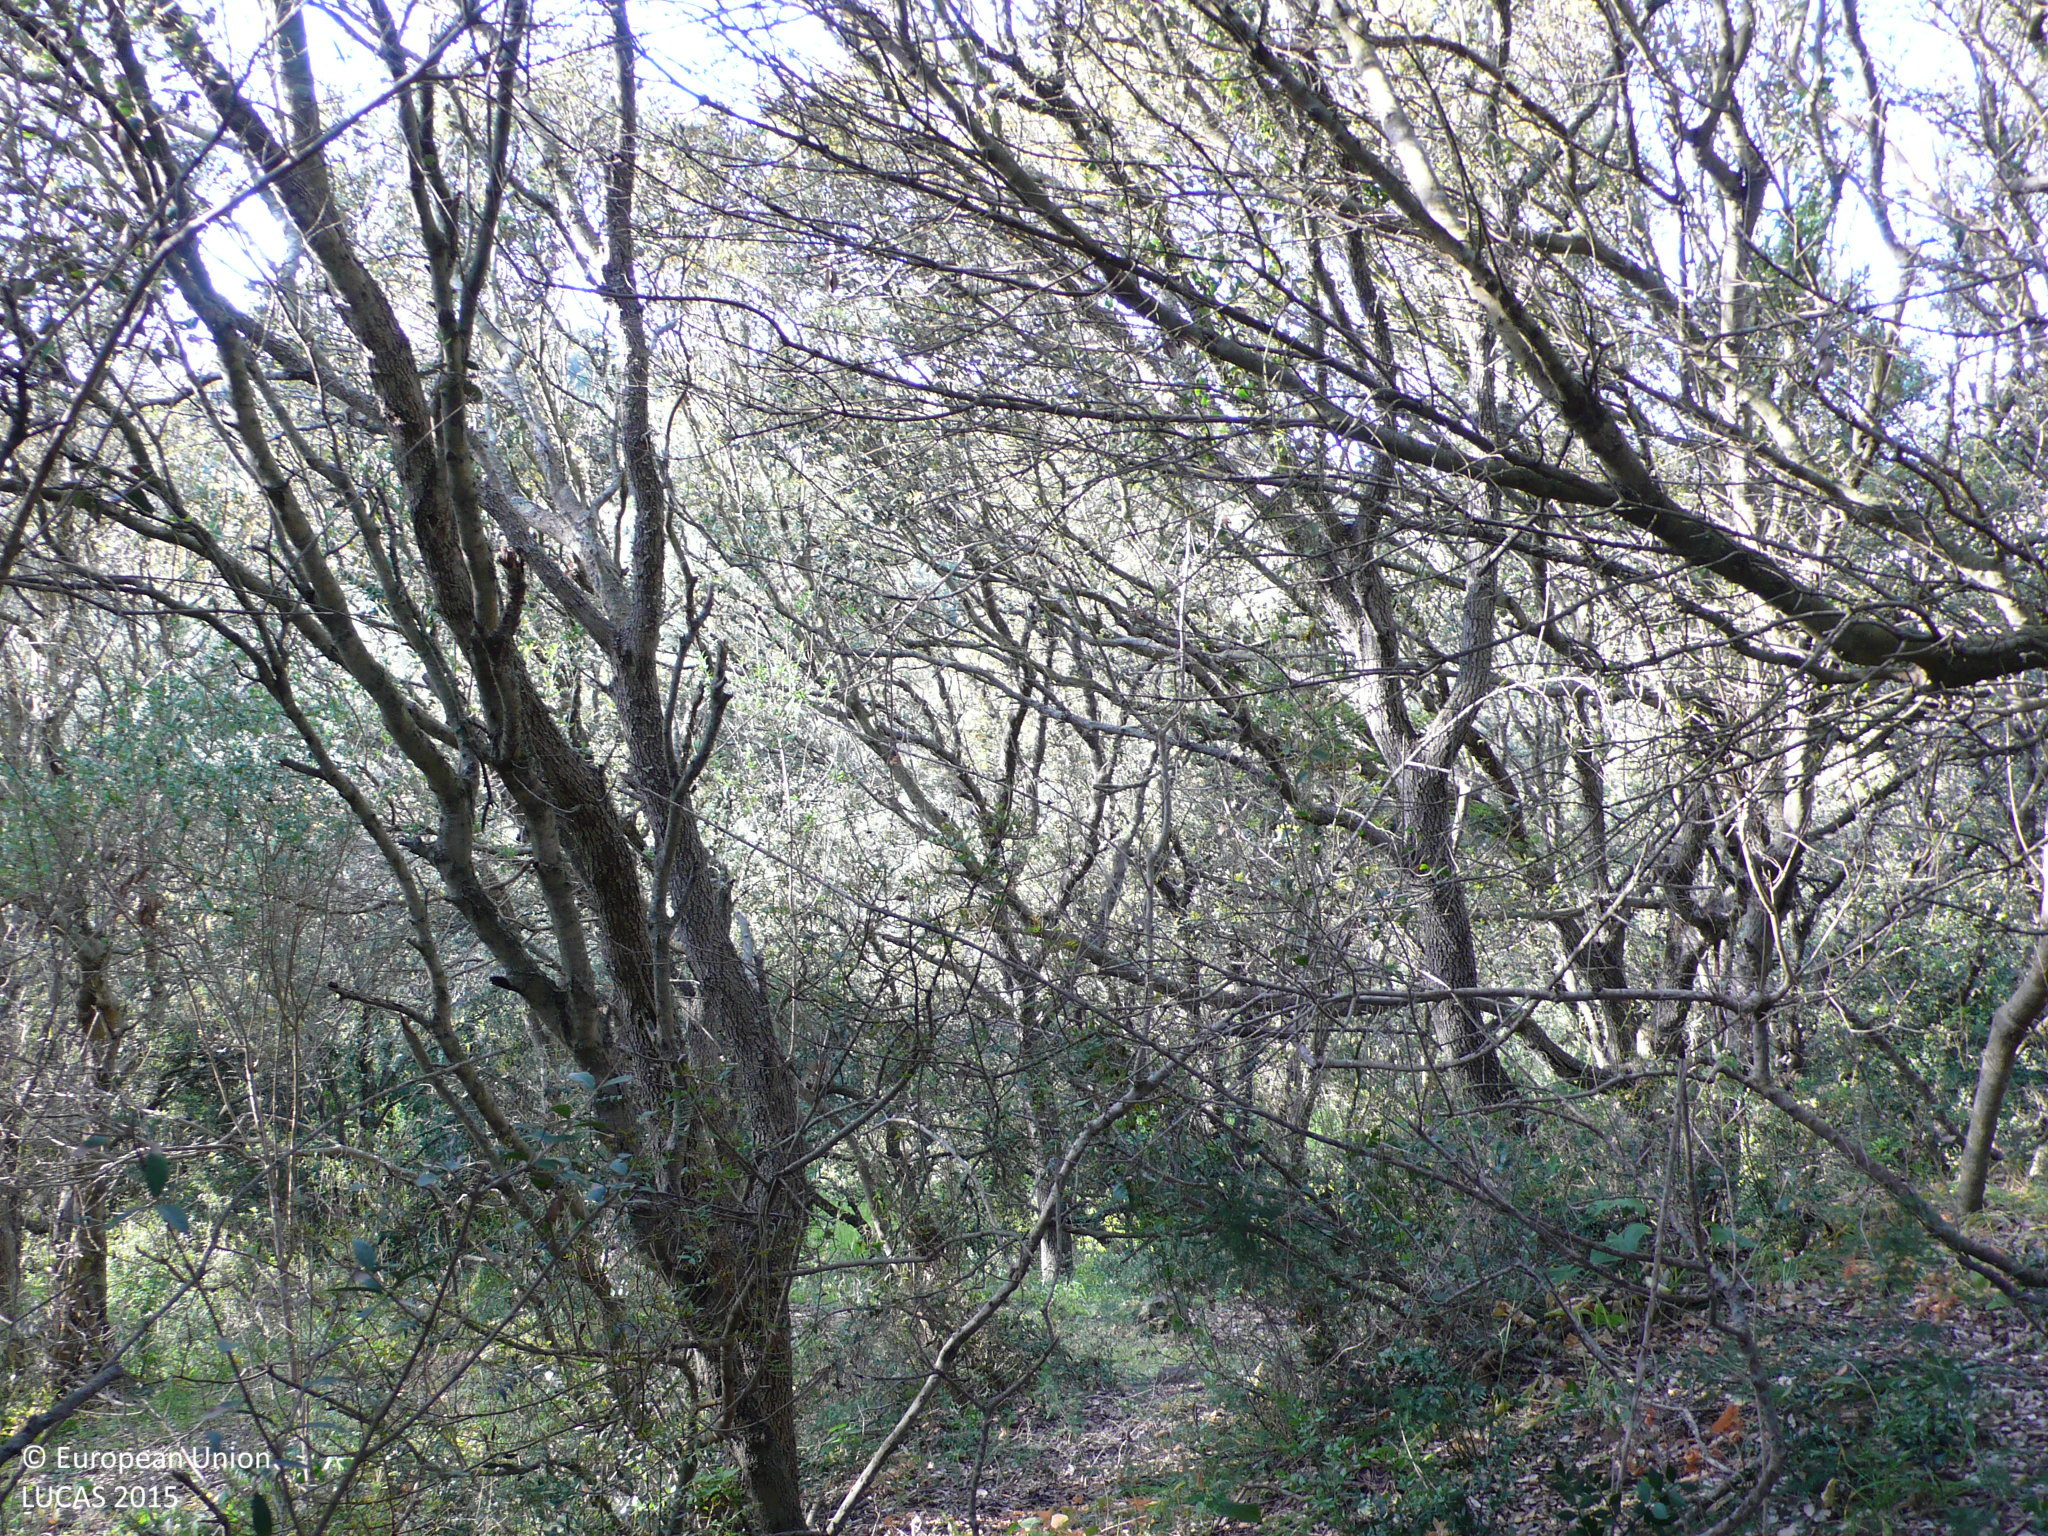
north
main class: Woodland
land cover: Broadleaved woodland
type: thermophilous deciduous forest
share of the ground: > 75 %
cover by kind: broadleaved forest trees 90 %, shrubs 10 %
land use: Semi-natural and natural areas not in use
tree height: > 5 m
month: May
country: ES
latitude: 39.9982
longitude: 4.0874
